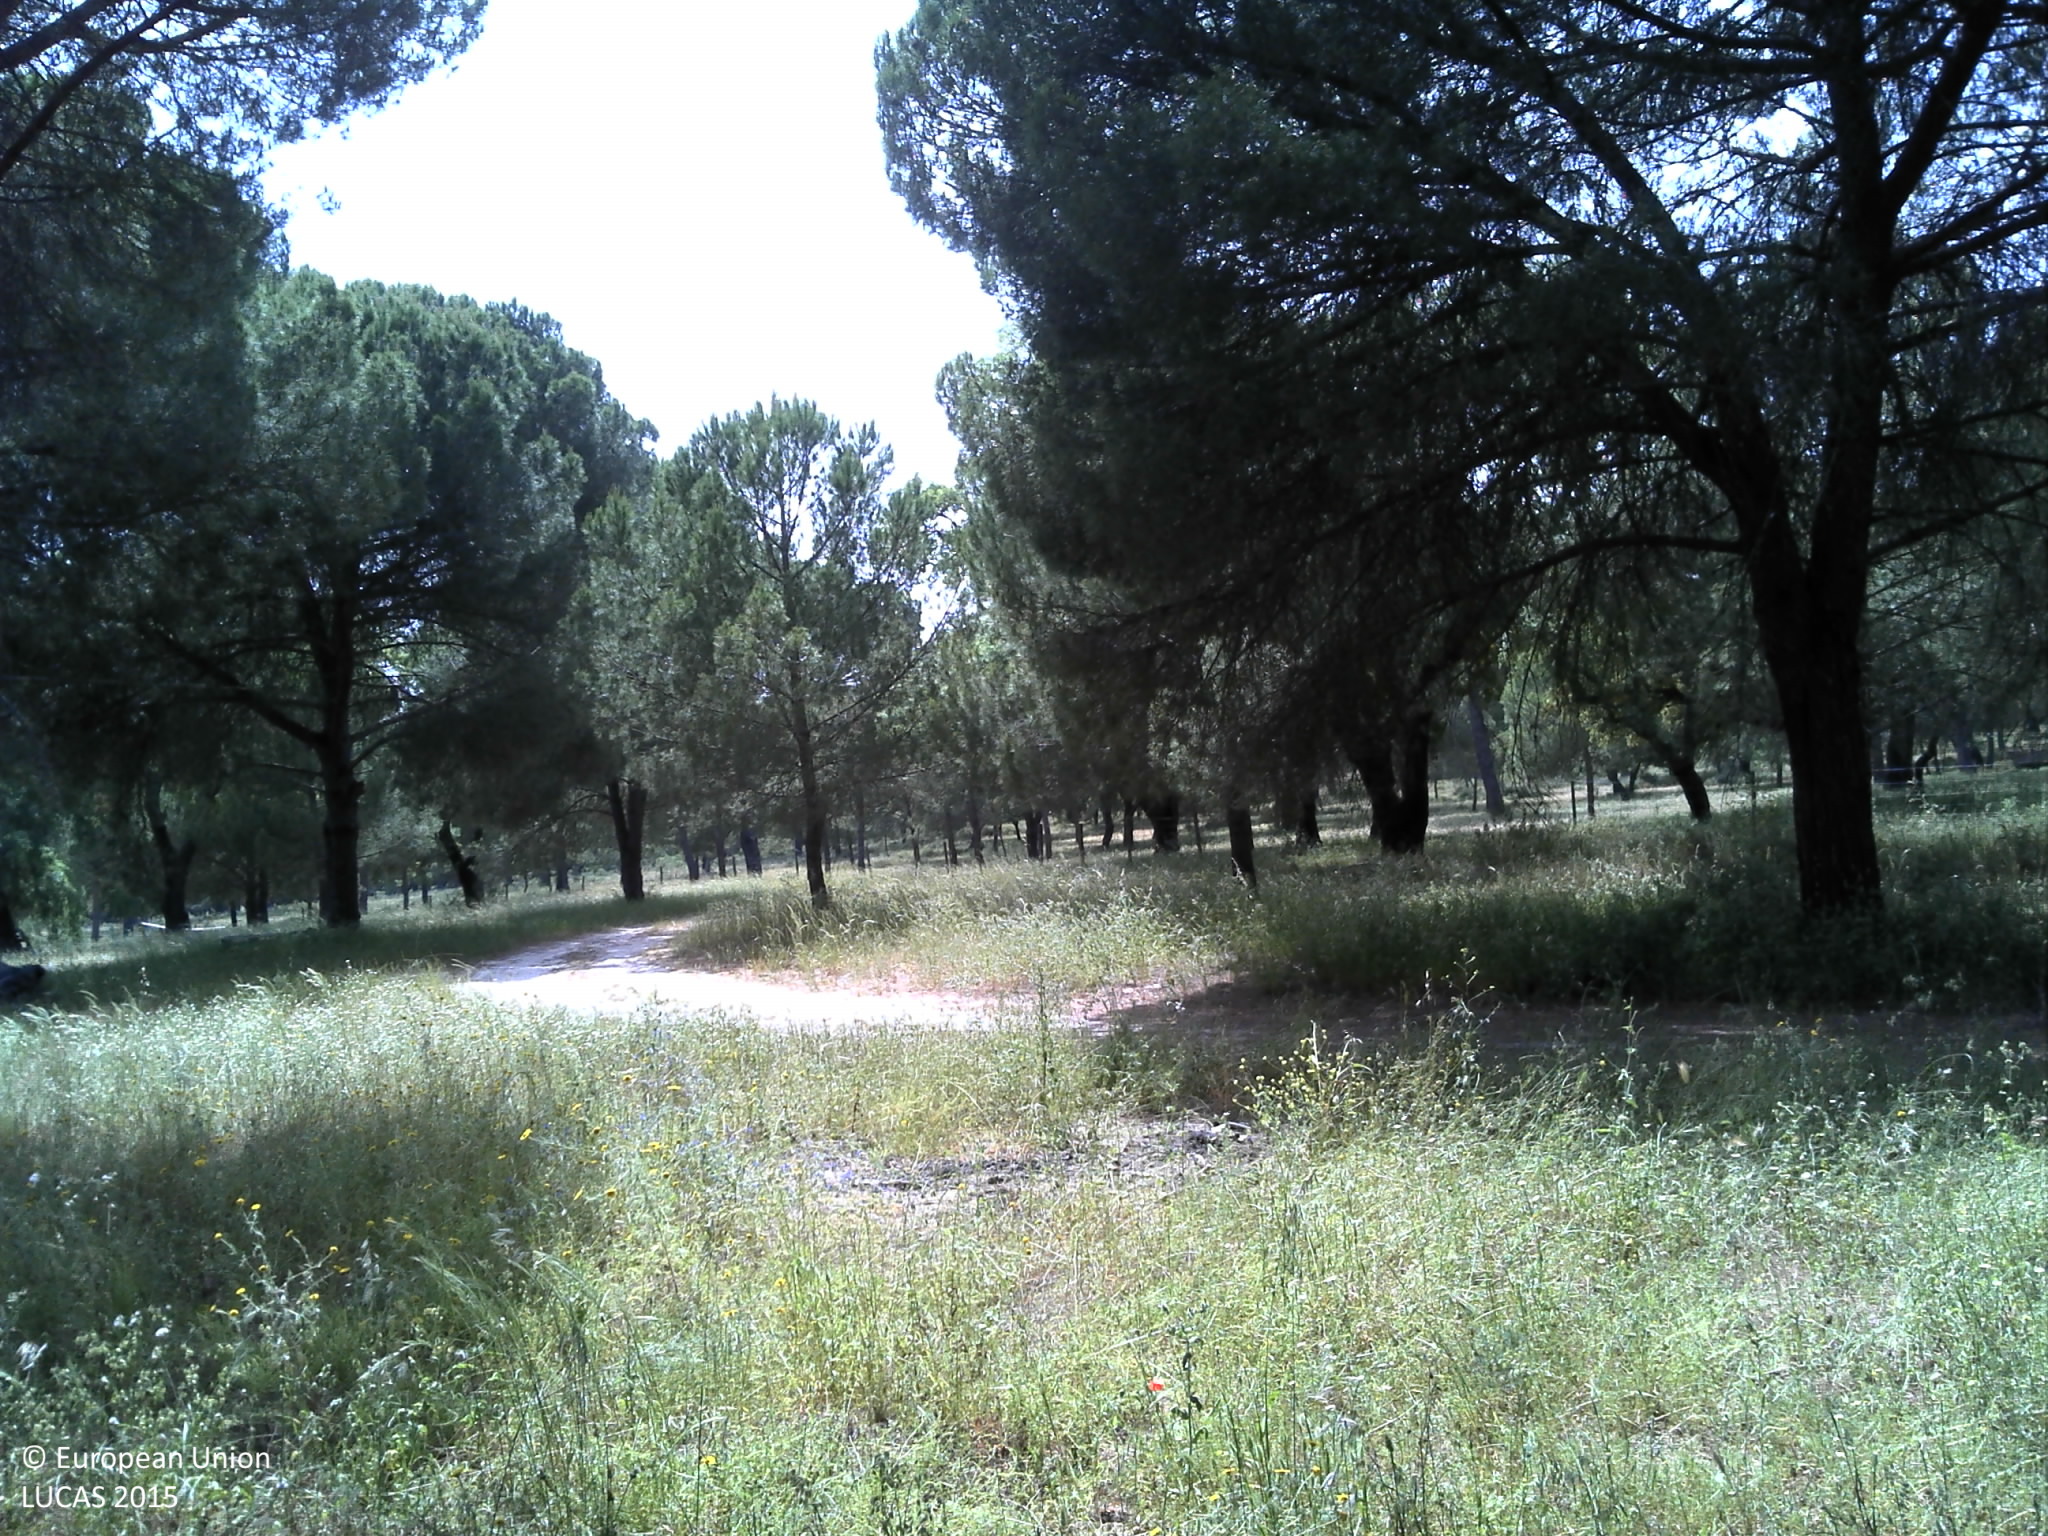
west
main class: Woodland
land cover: Pine dominated coniferous woodland
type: coniferous forest of the mediterranean region
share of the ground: > 75 %
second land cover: Spontaneously vegetated surfaces
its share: > 75 %
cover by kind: coniferous forest trees 75 %, herbaceous plants 25 %
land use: Forestry
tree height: > 5 m
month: May
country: PT
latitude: 38.3853
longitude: -8.4702
